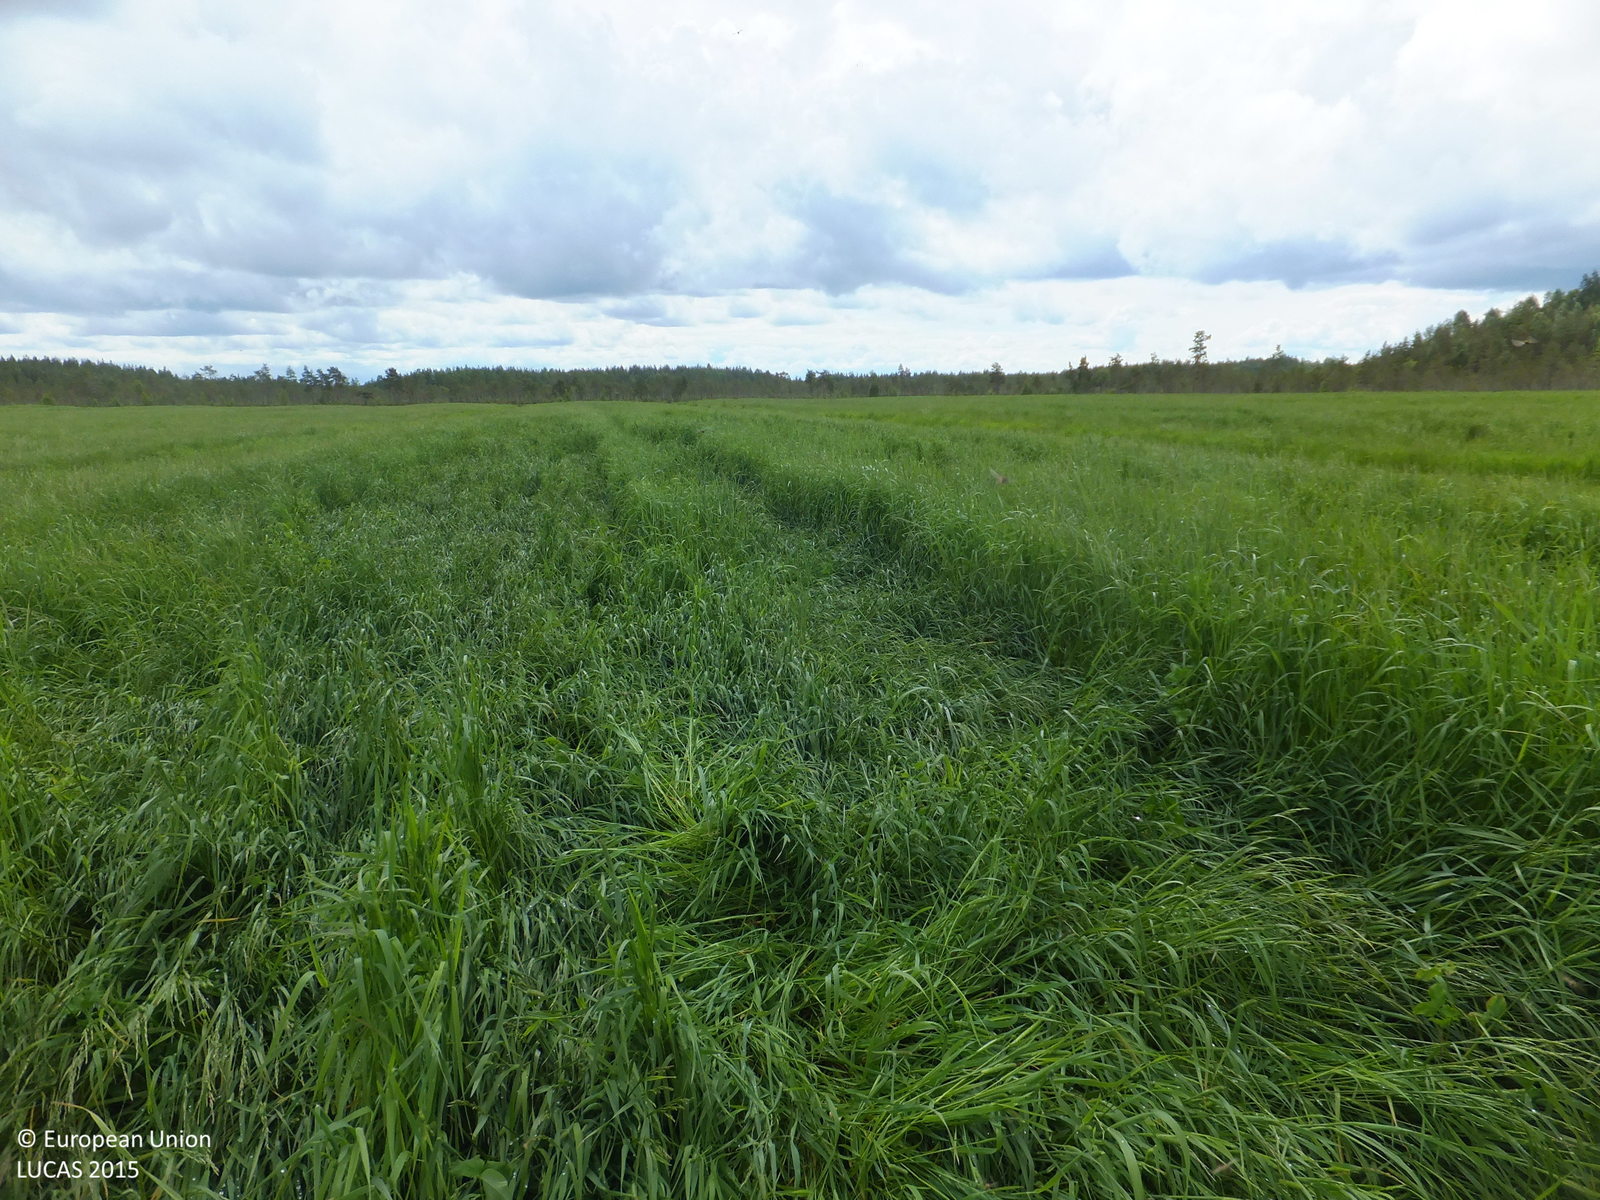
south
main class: Cropland
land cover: Temporary grasslands
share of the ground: > 75 %
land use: Agriculture (excluding fallow land and kitchen gardens)
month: June
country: FI
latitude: 63.3188
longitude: 23.9446
